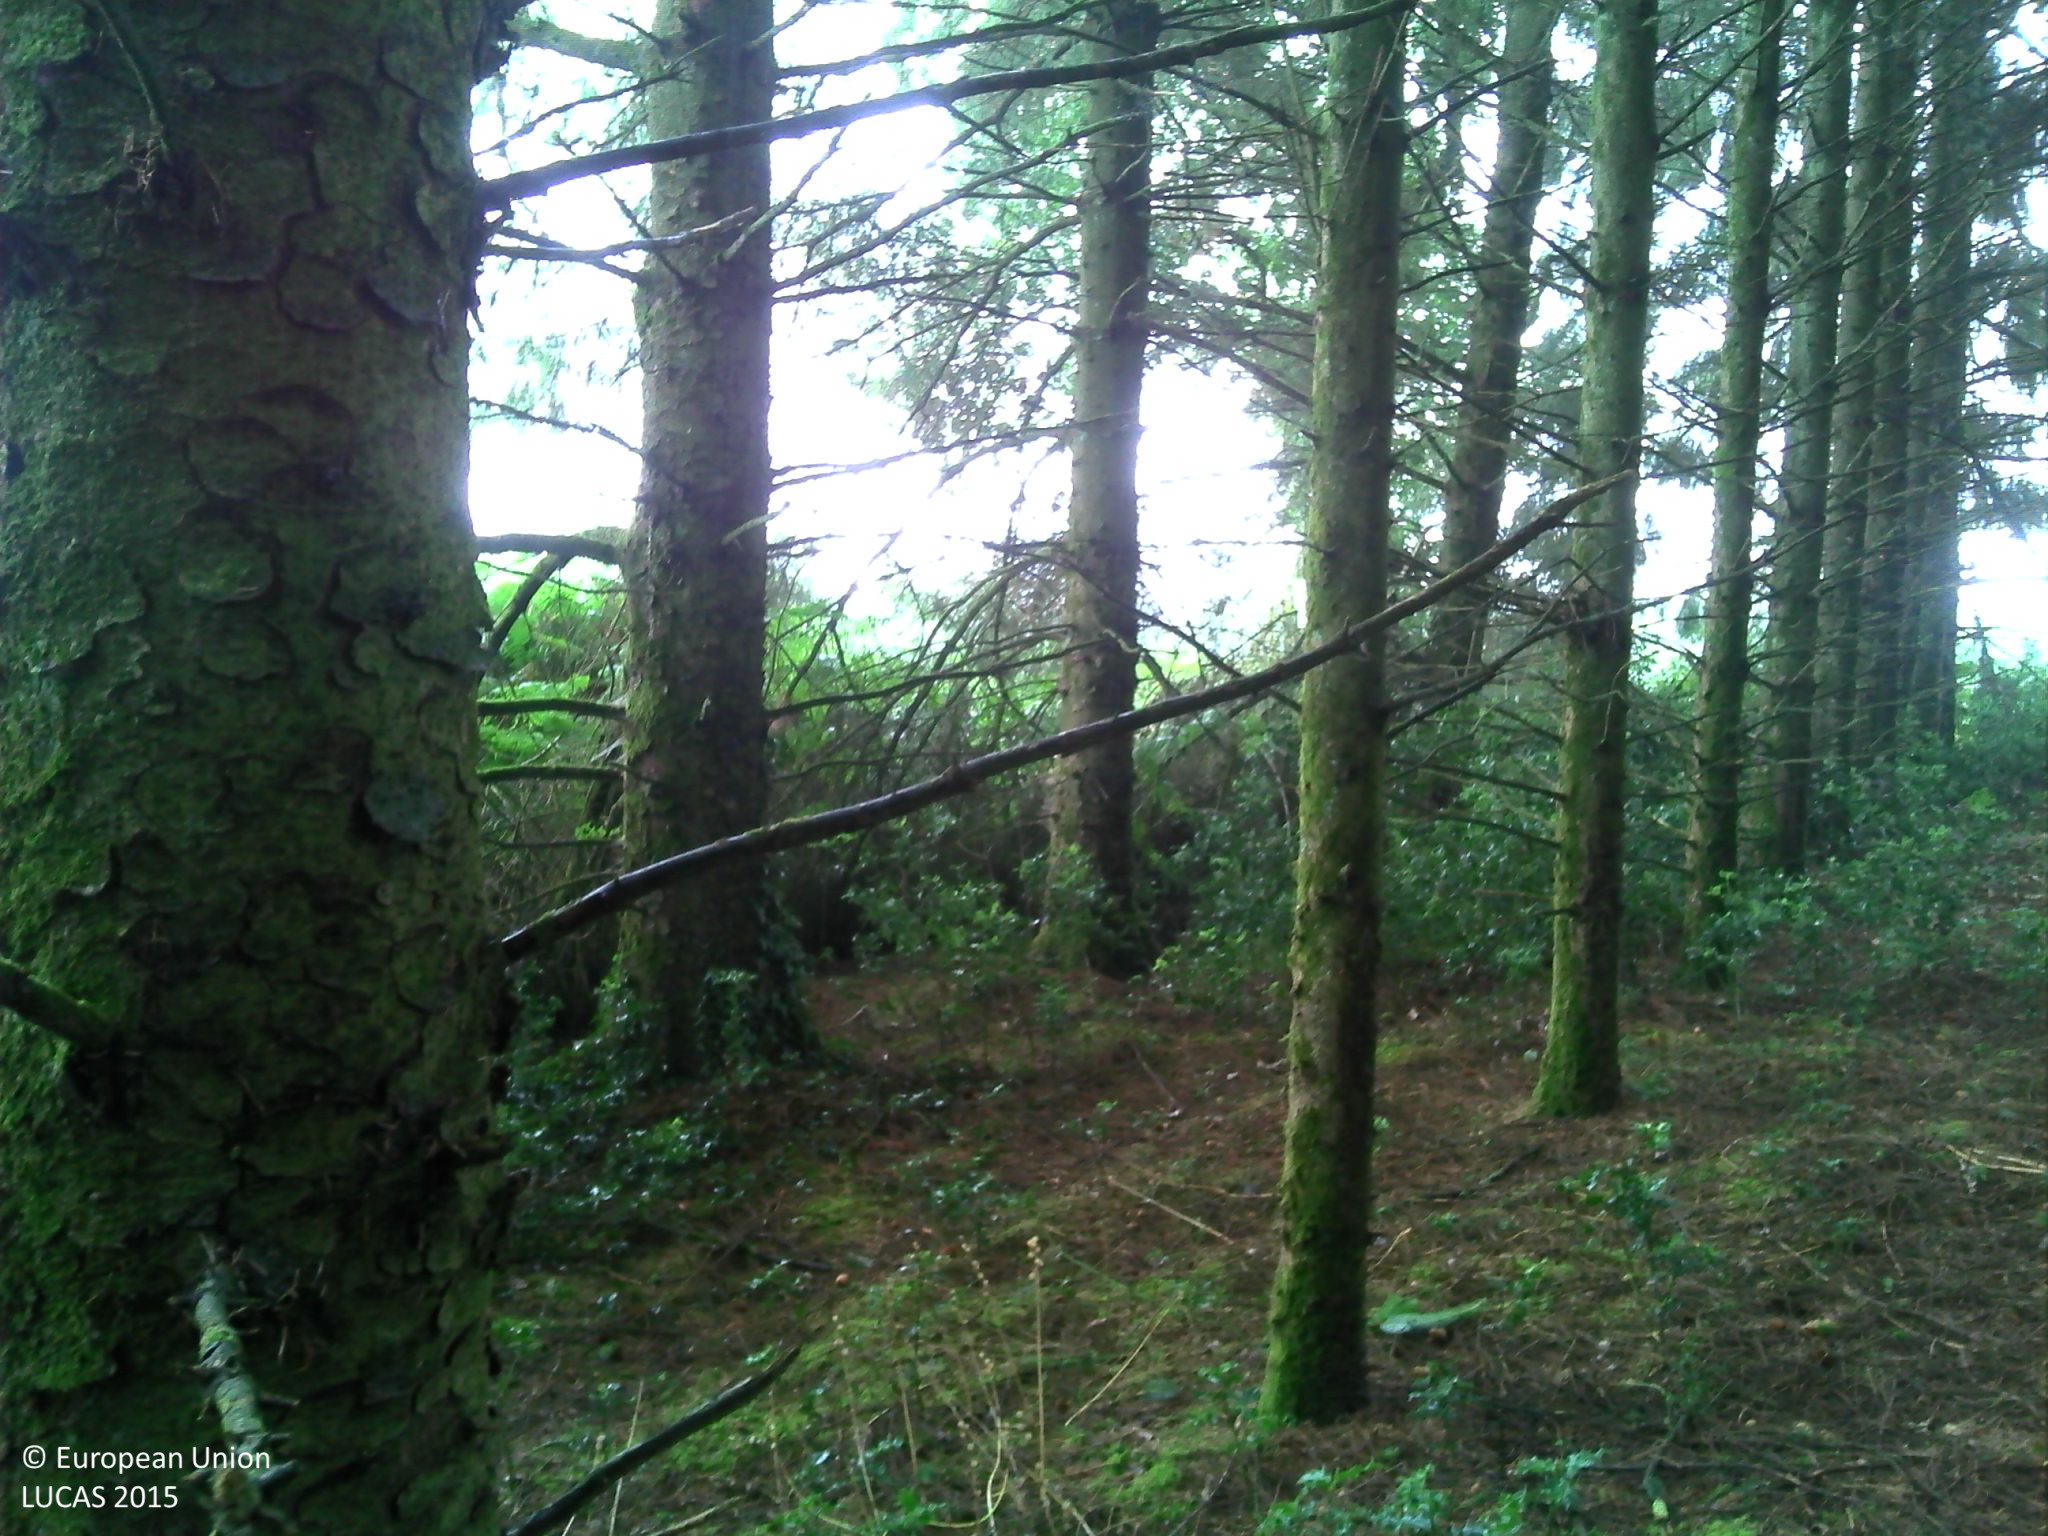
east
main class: Woodland
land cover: Other coniferous woodland
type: exotic forest
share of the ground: > 75 %
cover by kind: coniferous forest trees 90 %, herbaceous plants 10 %
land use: Forestry
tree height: > 5 m
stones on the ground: < 10 %
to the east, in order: Other coniferous woodland; Abandoned hedges; Rye; Tracks; Abandoned hedges; Rye; Electric lines; Grass margins; Paved roads, cycling and walking lanes; Grass margins; Shrubland without tree cover; Spruce dominated mixed woodland; Shrubland without tree cover
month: August
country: FR
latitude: 48.3998
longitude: -3.1333
